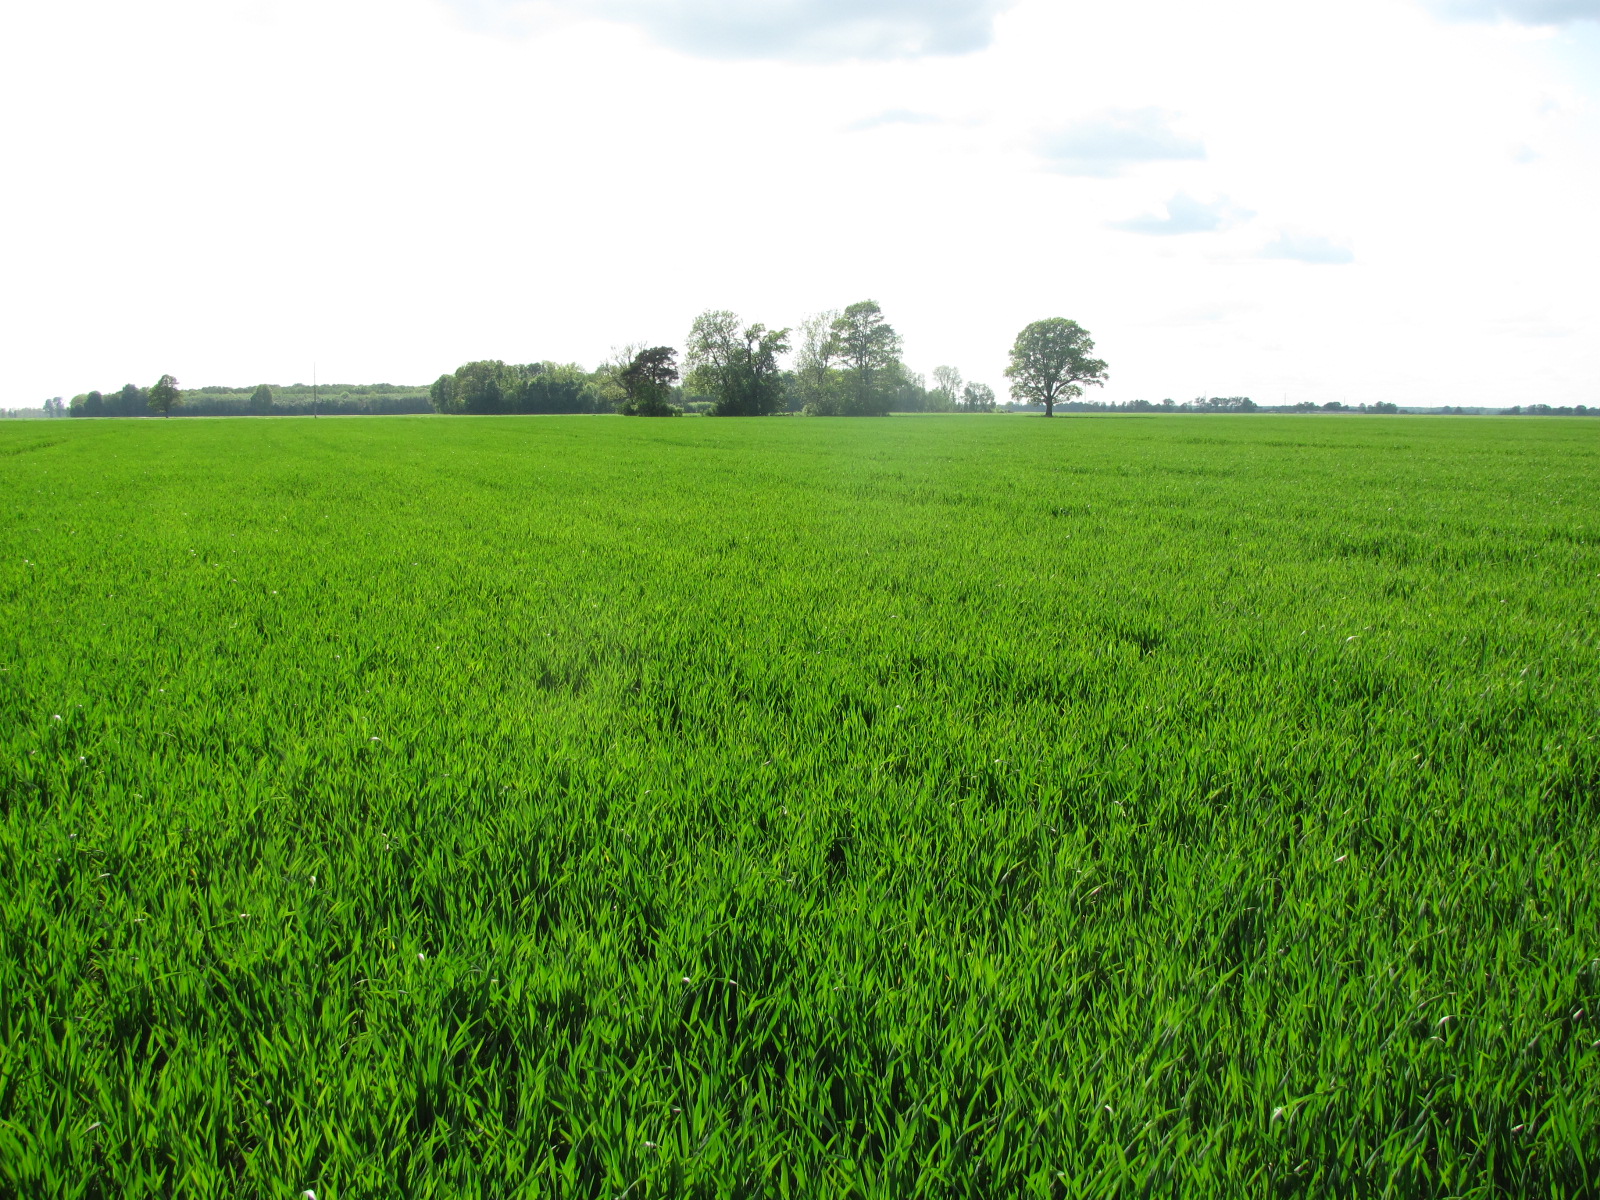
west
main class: Cropland
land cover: Common wheat
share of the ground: > 75 %
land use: Agriculture (excluding fallow land and kitchen gardens)
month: May
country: LV
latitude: 56.5423
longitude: 23.8903
